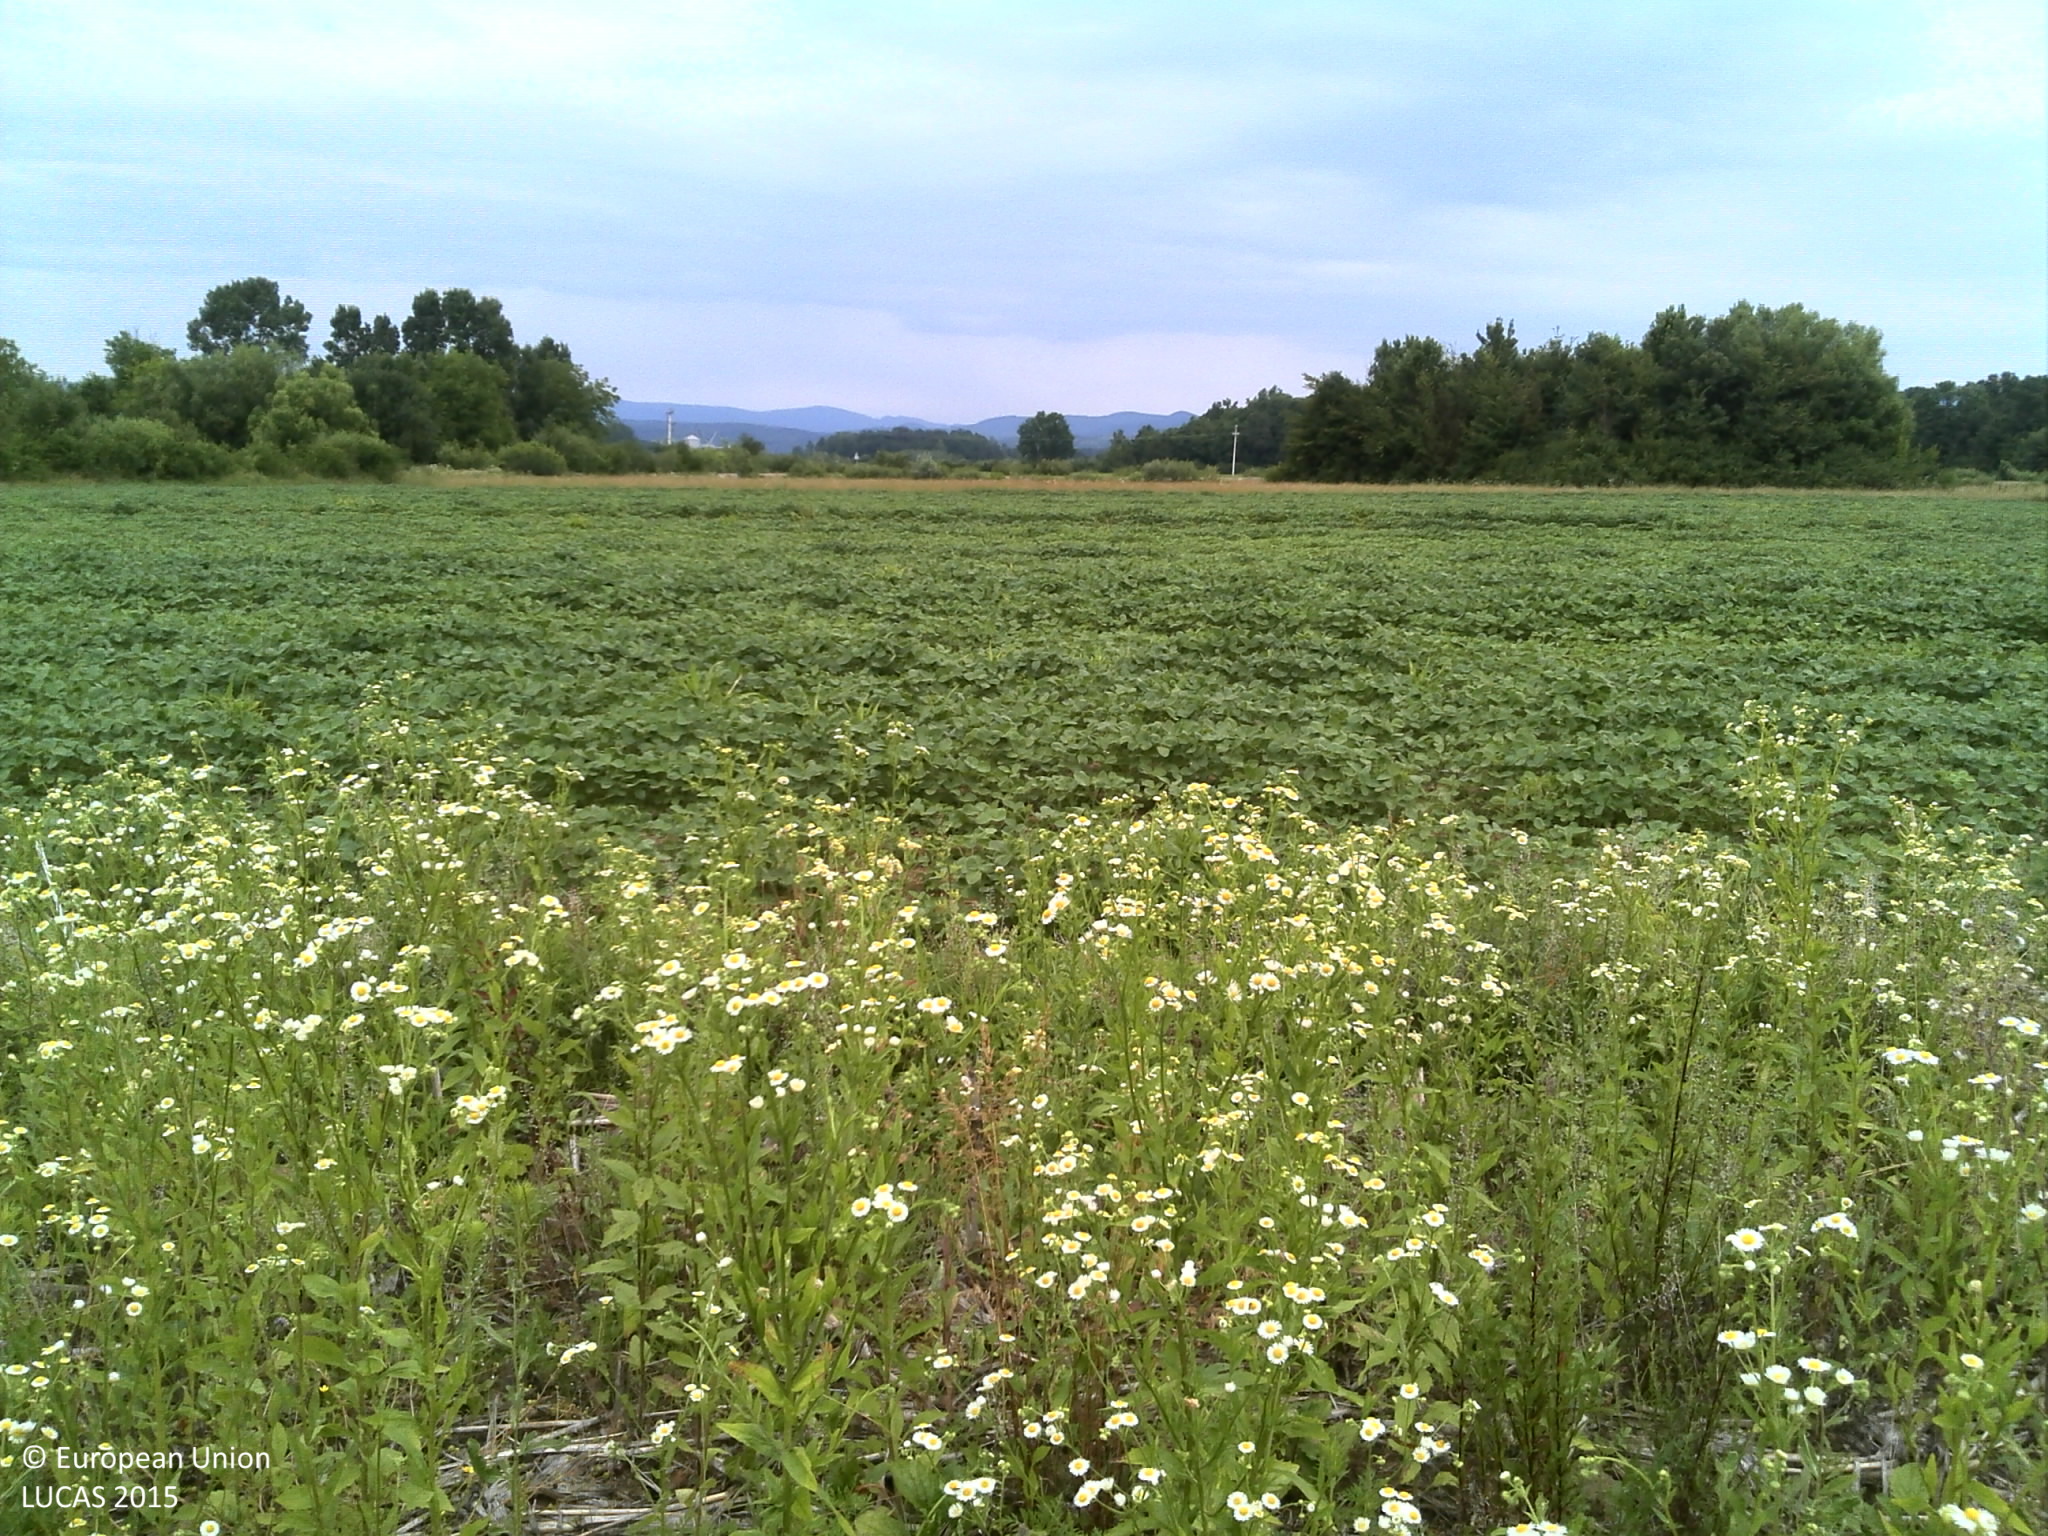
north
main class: Grassland
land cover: Spontaneously vegetated surfaces
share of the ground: 25 - 50 %
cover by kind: herbaceous plants 50 %, unconsolidated bare surface 50 %
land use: Fallow land
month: June
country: HR
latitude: 45.2031
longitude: 17.4733
